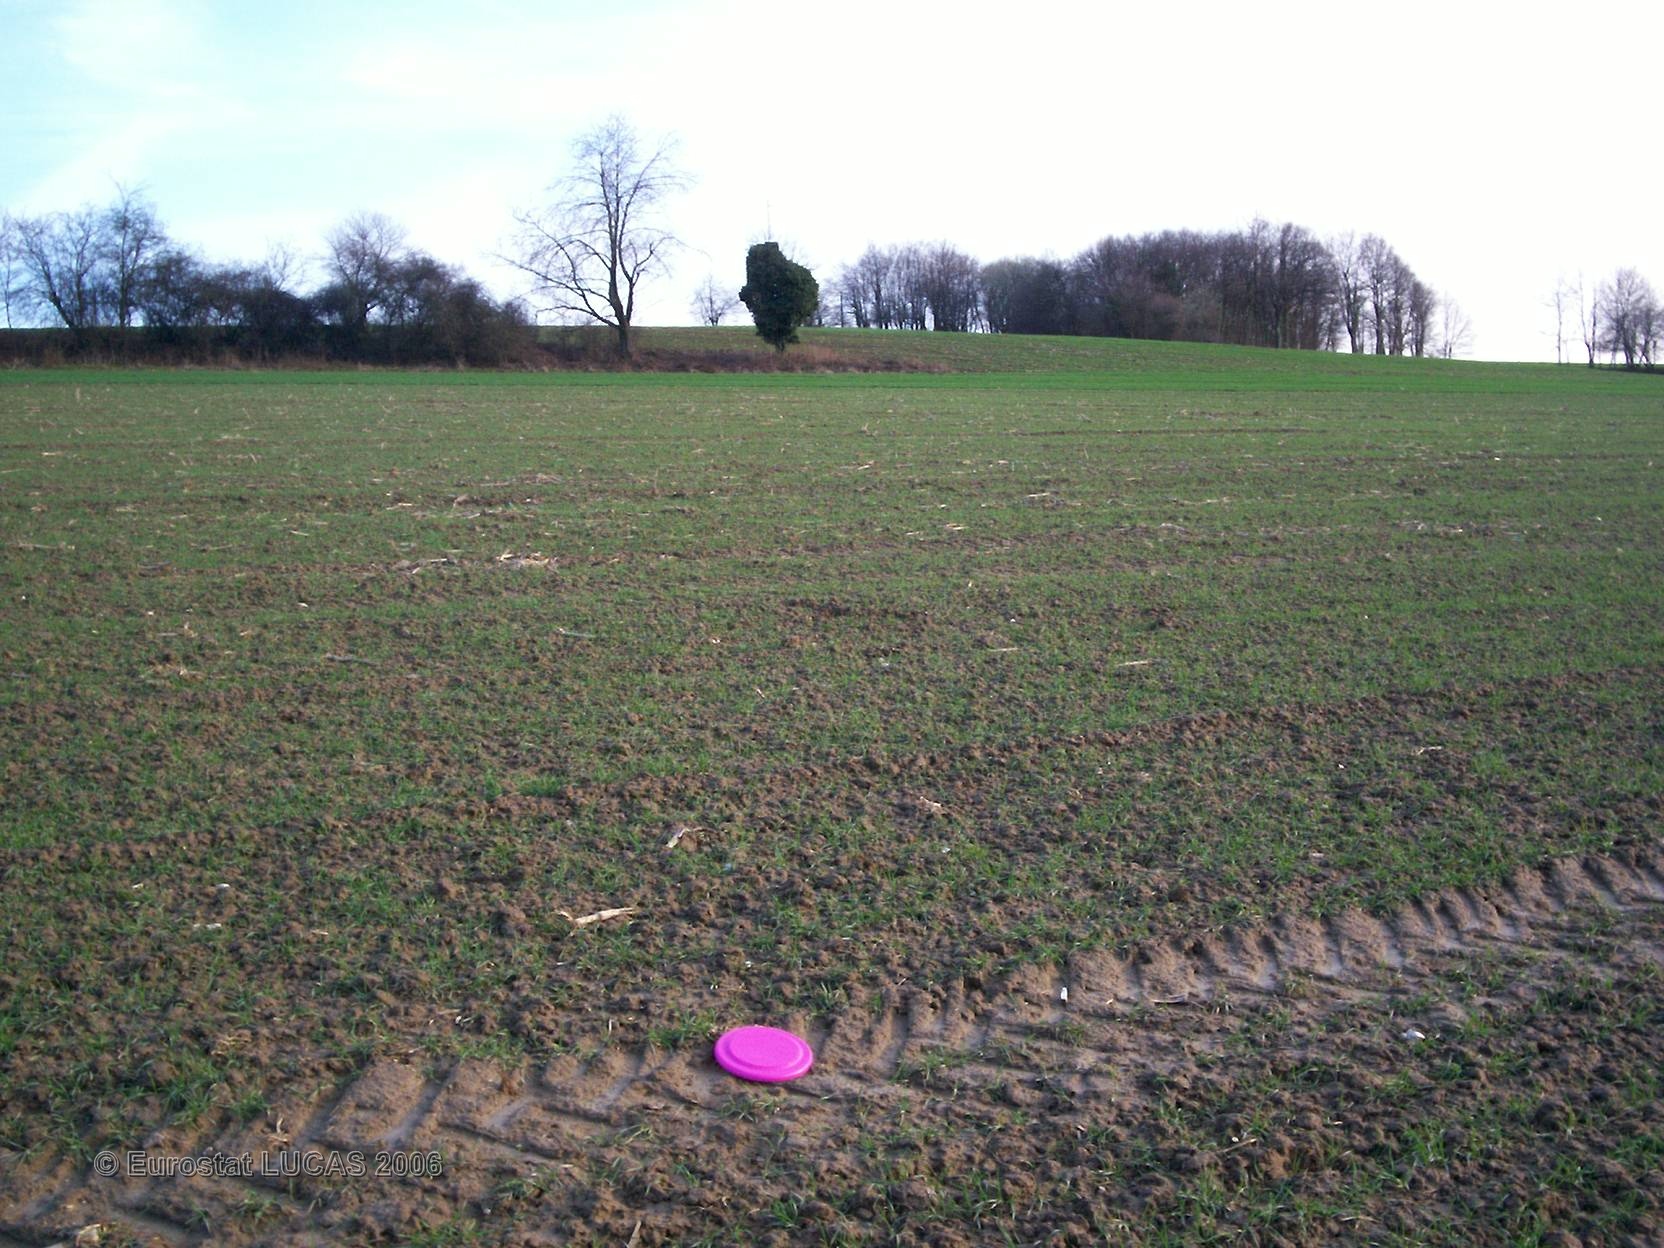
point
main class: Cropland
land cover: Common wheat
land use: Agriculture (excluding fallow land and kitchen gardens)
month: April
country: FR
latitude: 47.4621
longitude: 6.9905
